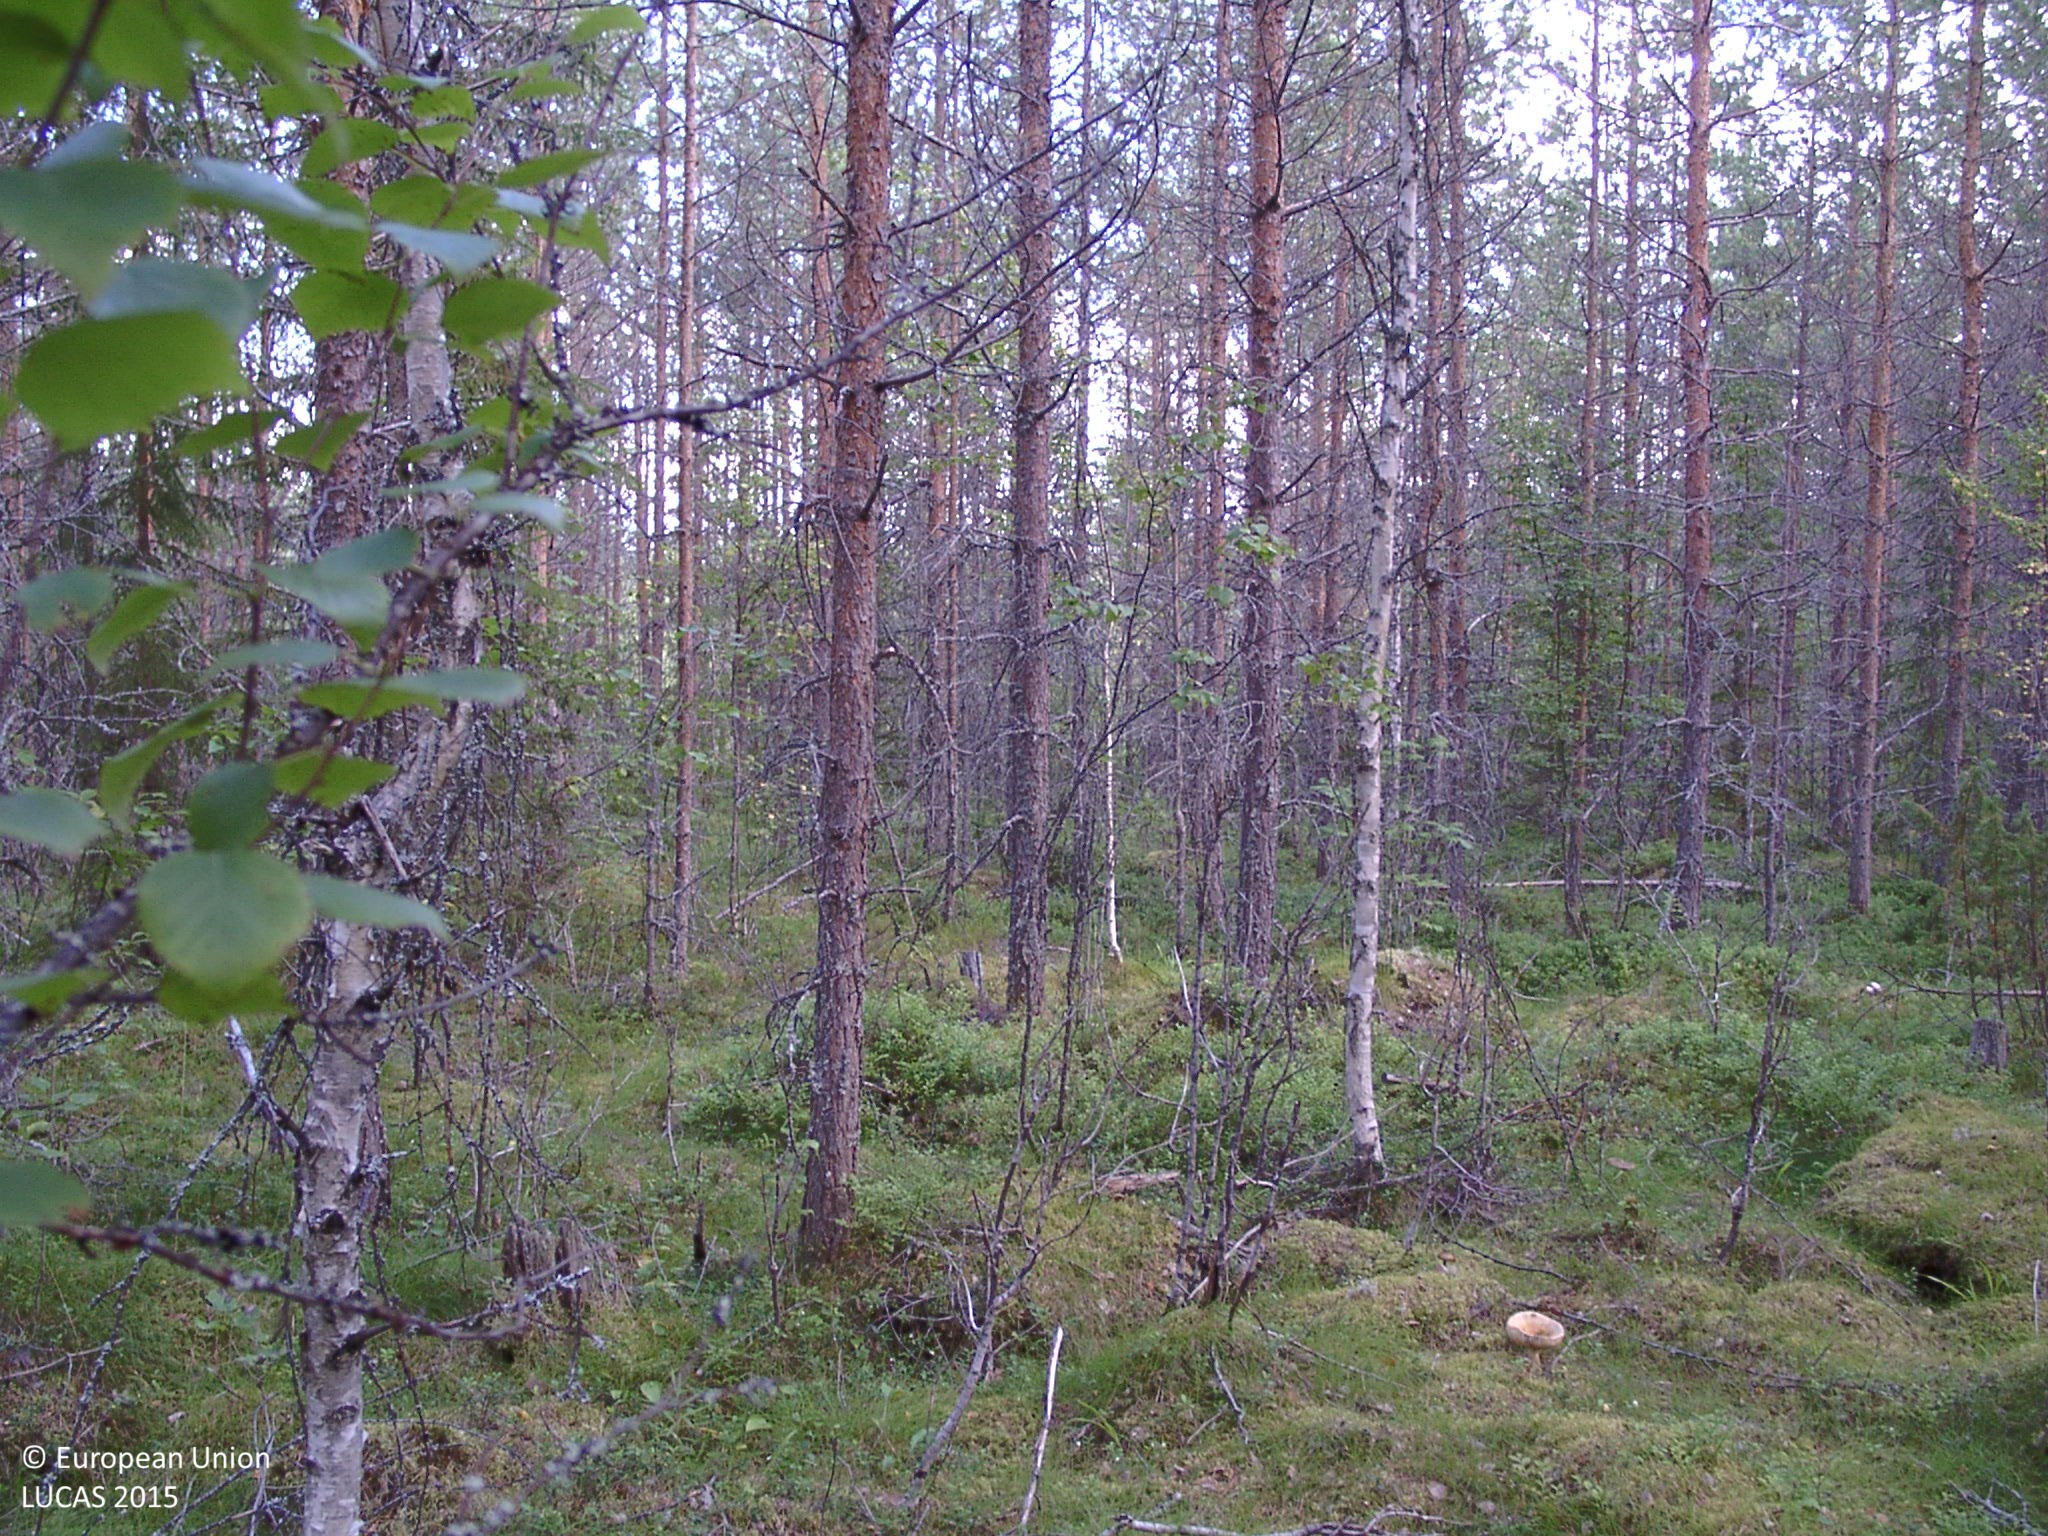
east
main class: Woodland
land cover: Pine dominated coniferous woodland
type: boreal forest
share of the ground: > 75 %
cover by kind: coniferous forest trees 75 %, shrubs 10 %, lichens and mosses 10 %, herbaceous plants 5 %
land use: Forestry
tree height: > 5 m
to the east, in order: Pine dominated coniferous woodland; Other mixed woodland; Pine dominated mixed woodland; Pine dominated coniferous woodland
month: August
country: FI
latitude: 62.9718
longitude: 25.0681
